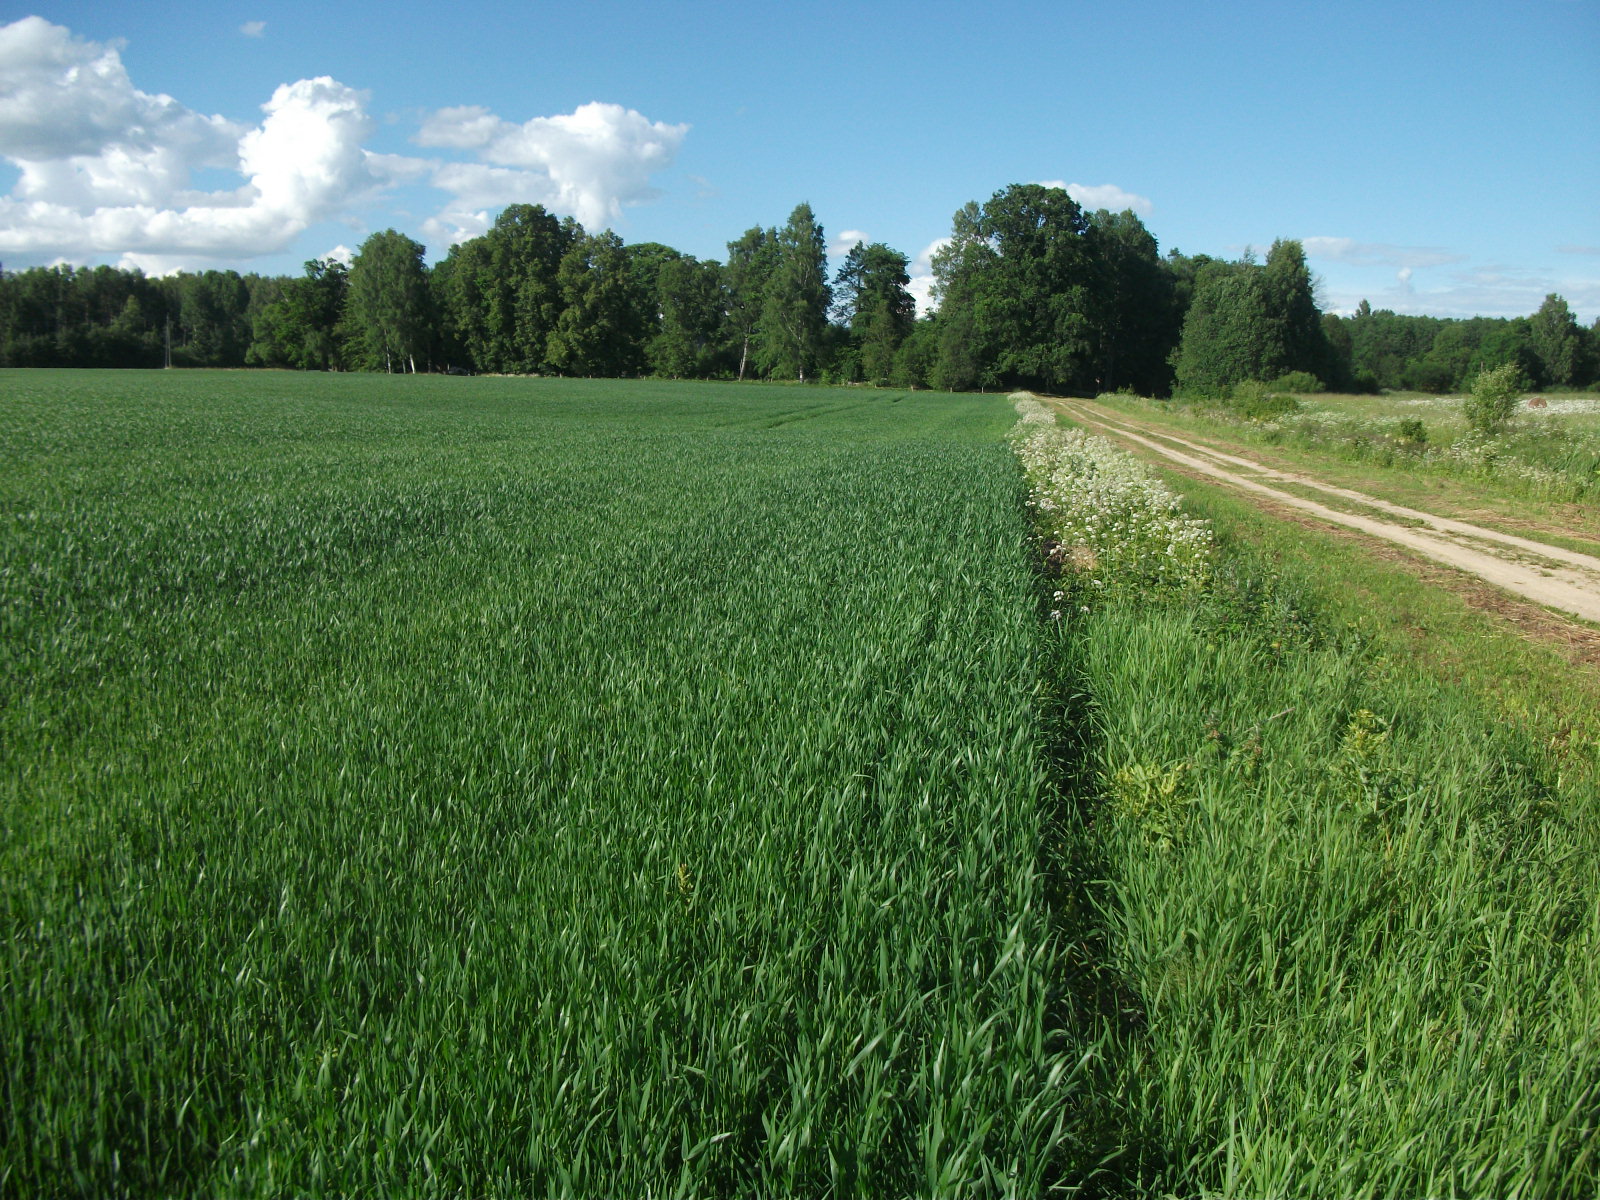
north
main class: Cropland
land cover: Common wheat
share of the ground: > 75 %
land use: Agriculture (excluding fallow land and kitchen gardens)
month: June
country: LV
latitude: 57.0100
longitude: 26.5989
